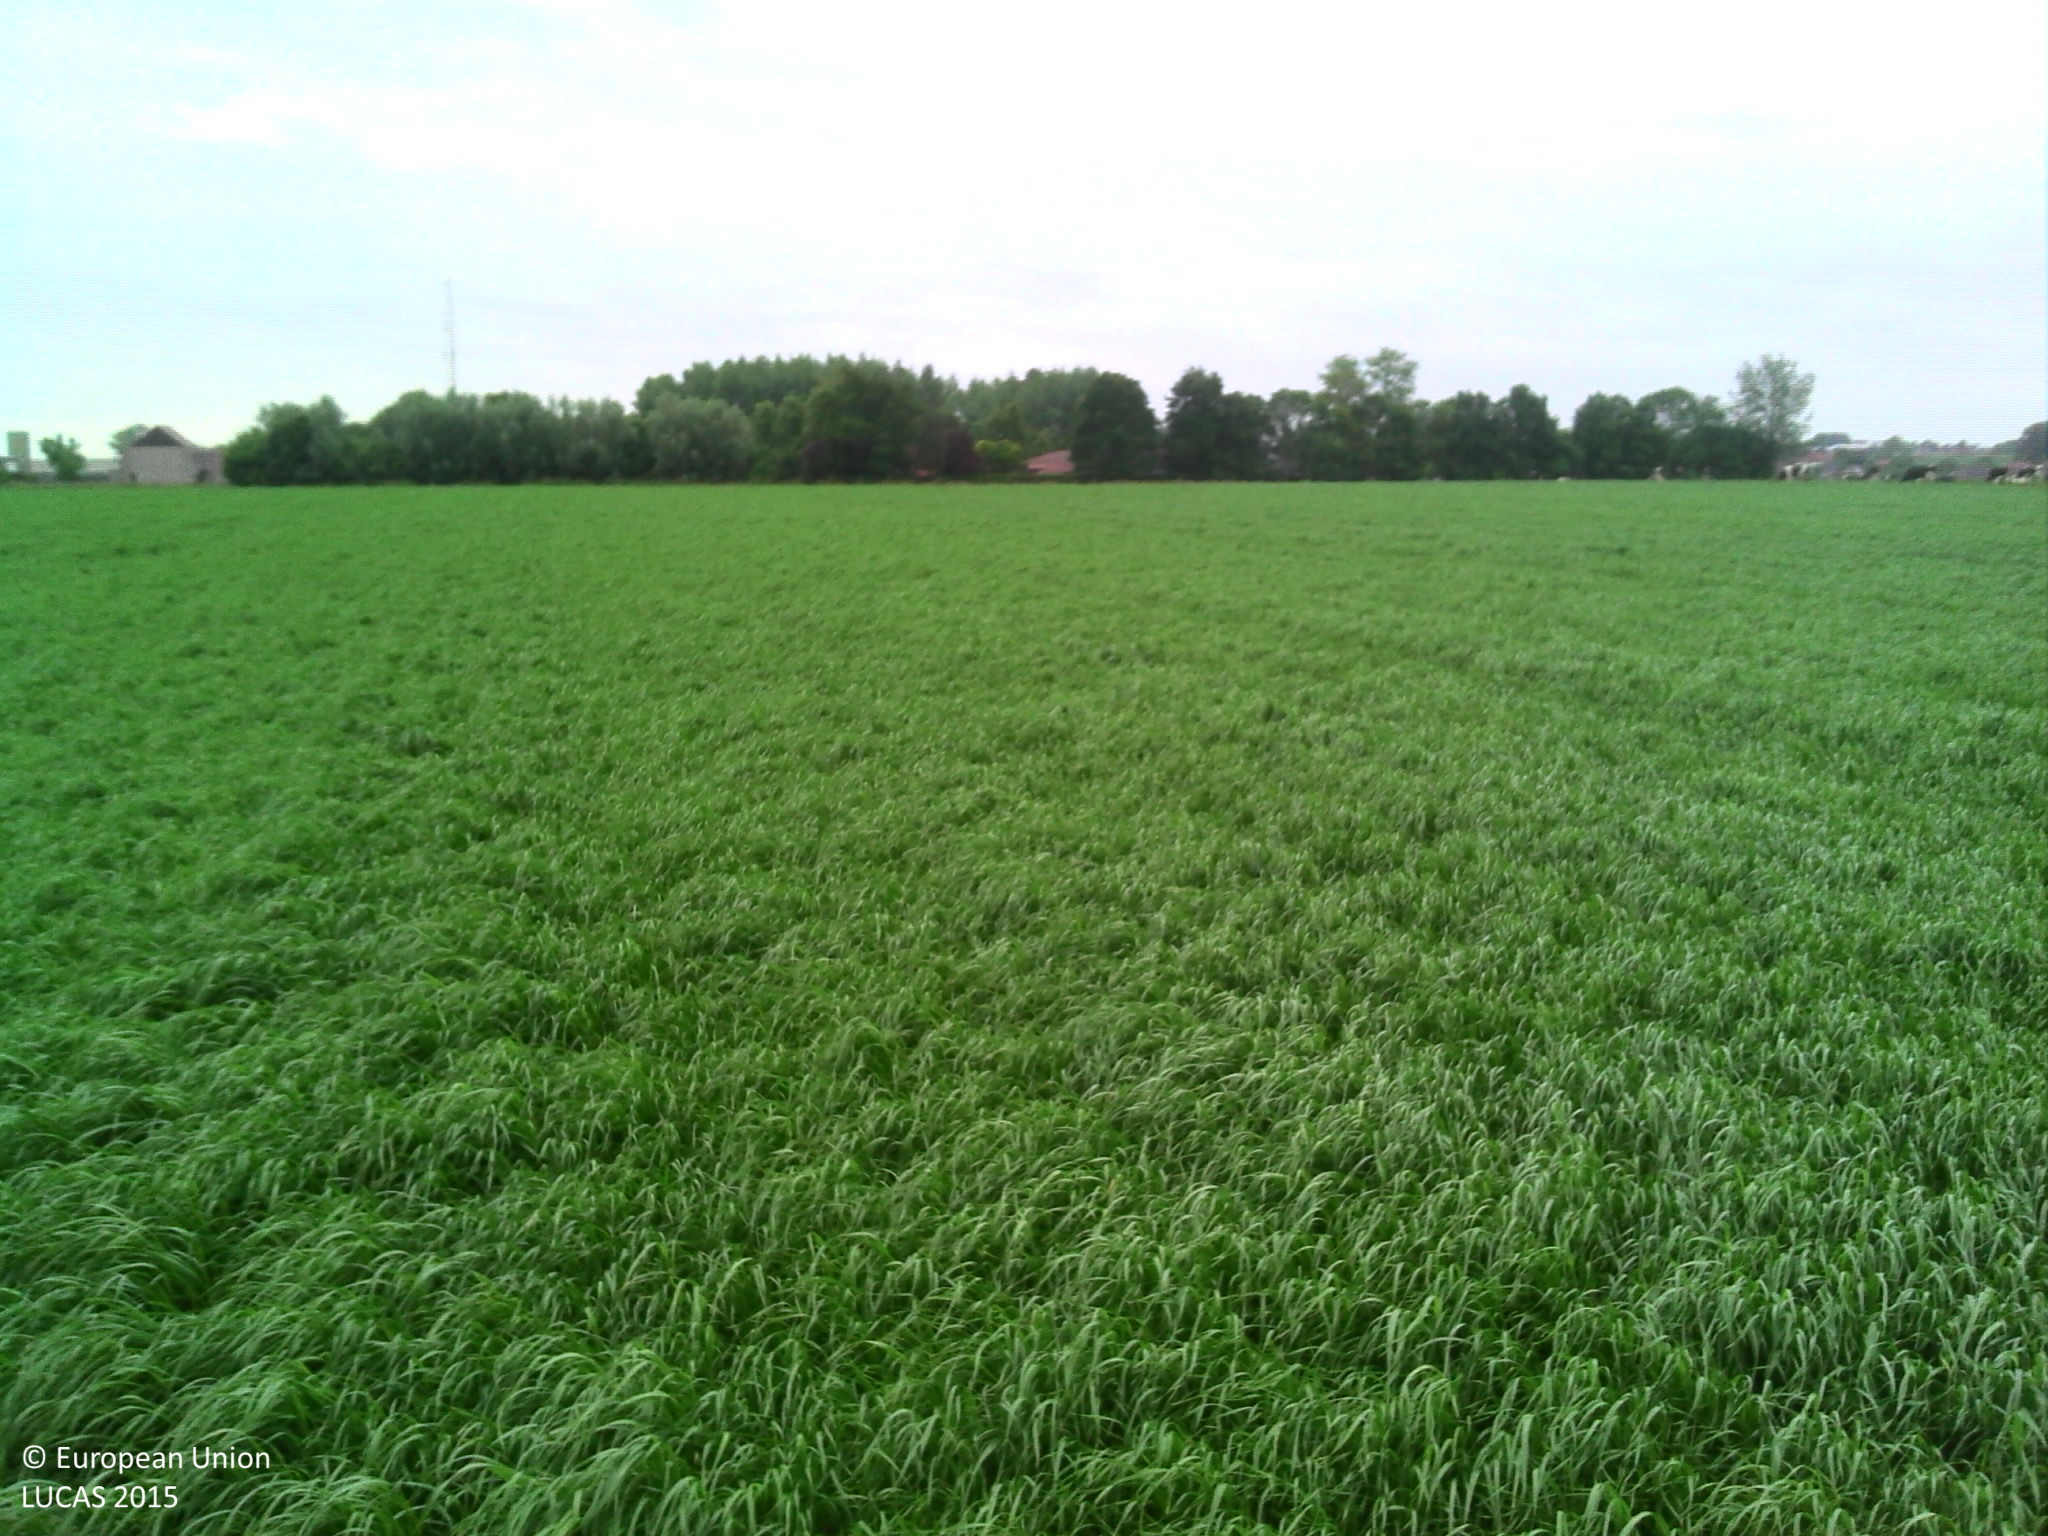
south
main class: Cropland
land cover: Temporary grasslands
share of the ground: > 75 %
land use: Agriculture (excluding fallow land and kitchen gardens)
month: June
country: BE
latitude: 50.8234
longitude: 3.7328
